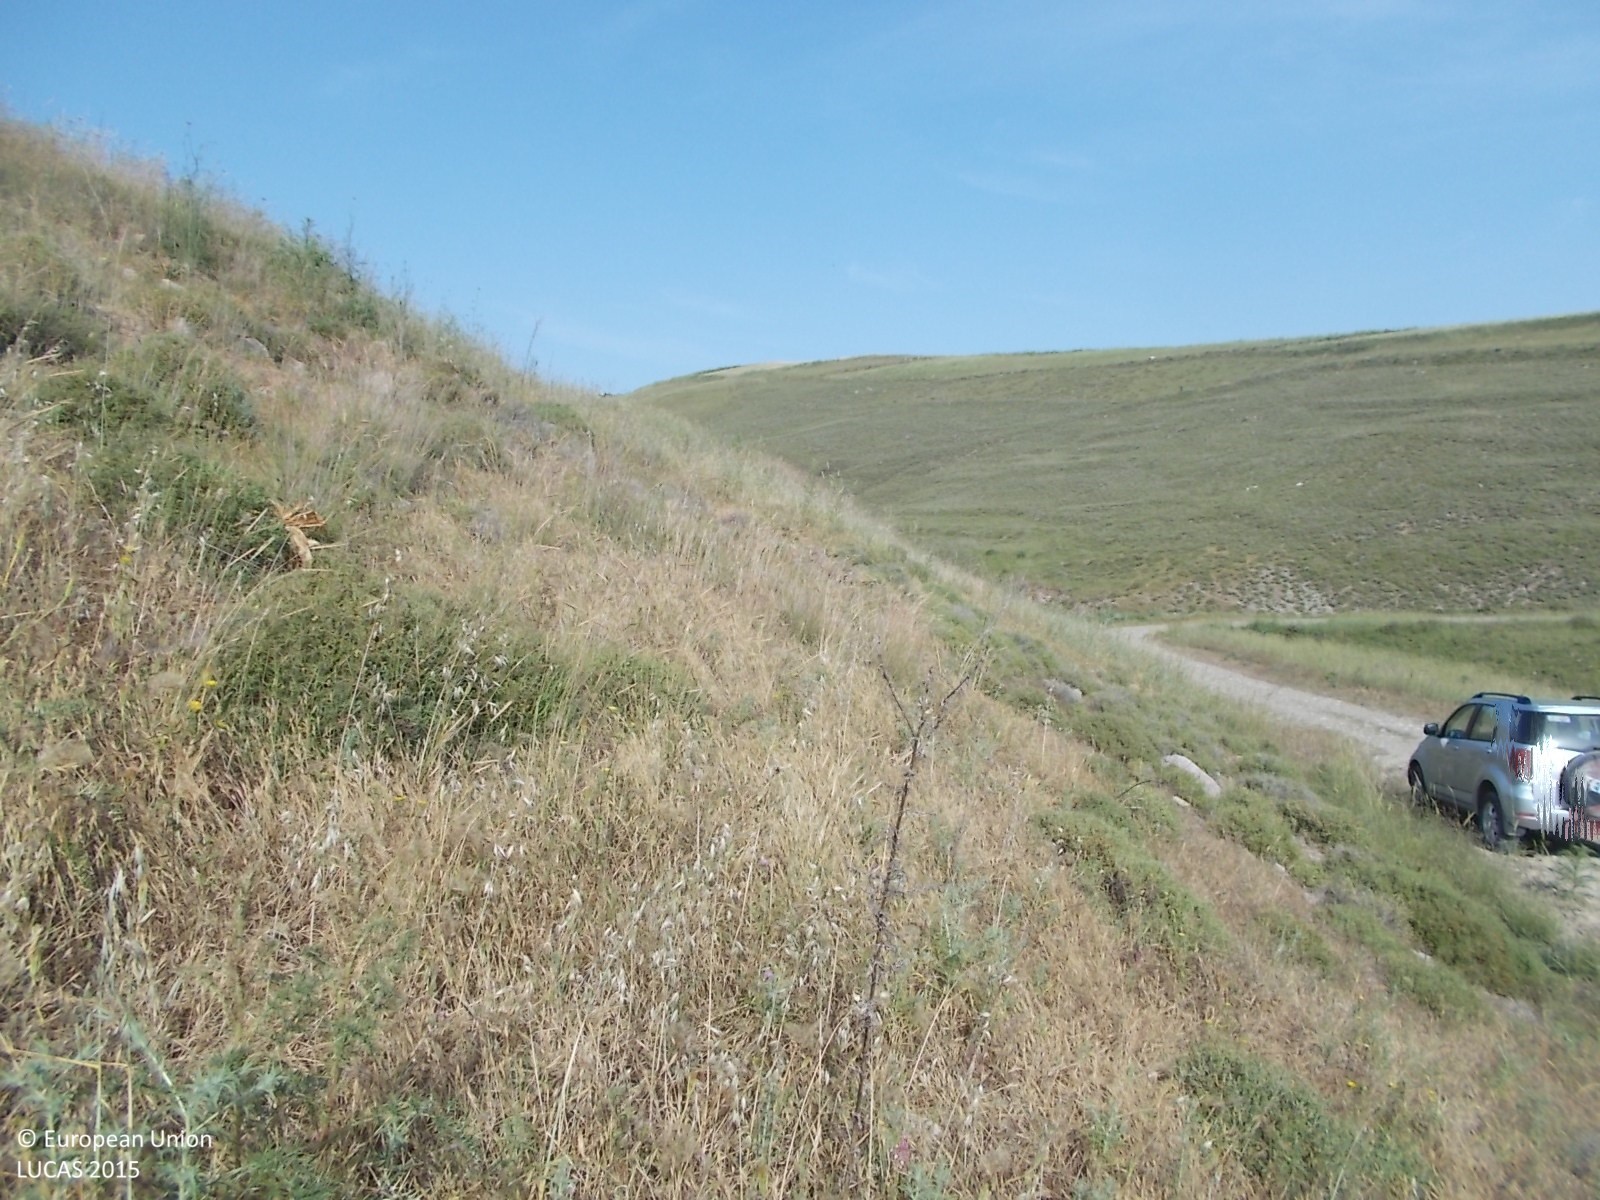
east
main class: Grassland
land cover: Grassland without tree/shrub cover
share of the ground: > 75 %
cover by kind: herbaceous plants 100 %
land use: Semi-natural and natural areas not in use
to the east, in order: Grassland without tree/shrub cover; Shrubland without tree cover; Grassland without tree/shrub cover; Rivers and streams; Shrubland without tree cover
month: May
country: CY
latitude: 34.9255
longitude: 32.4039
